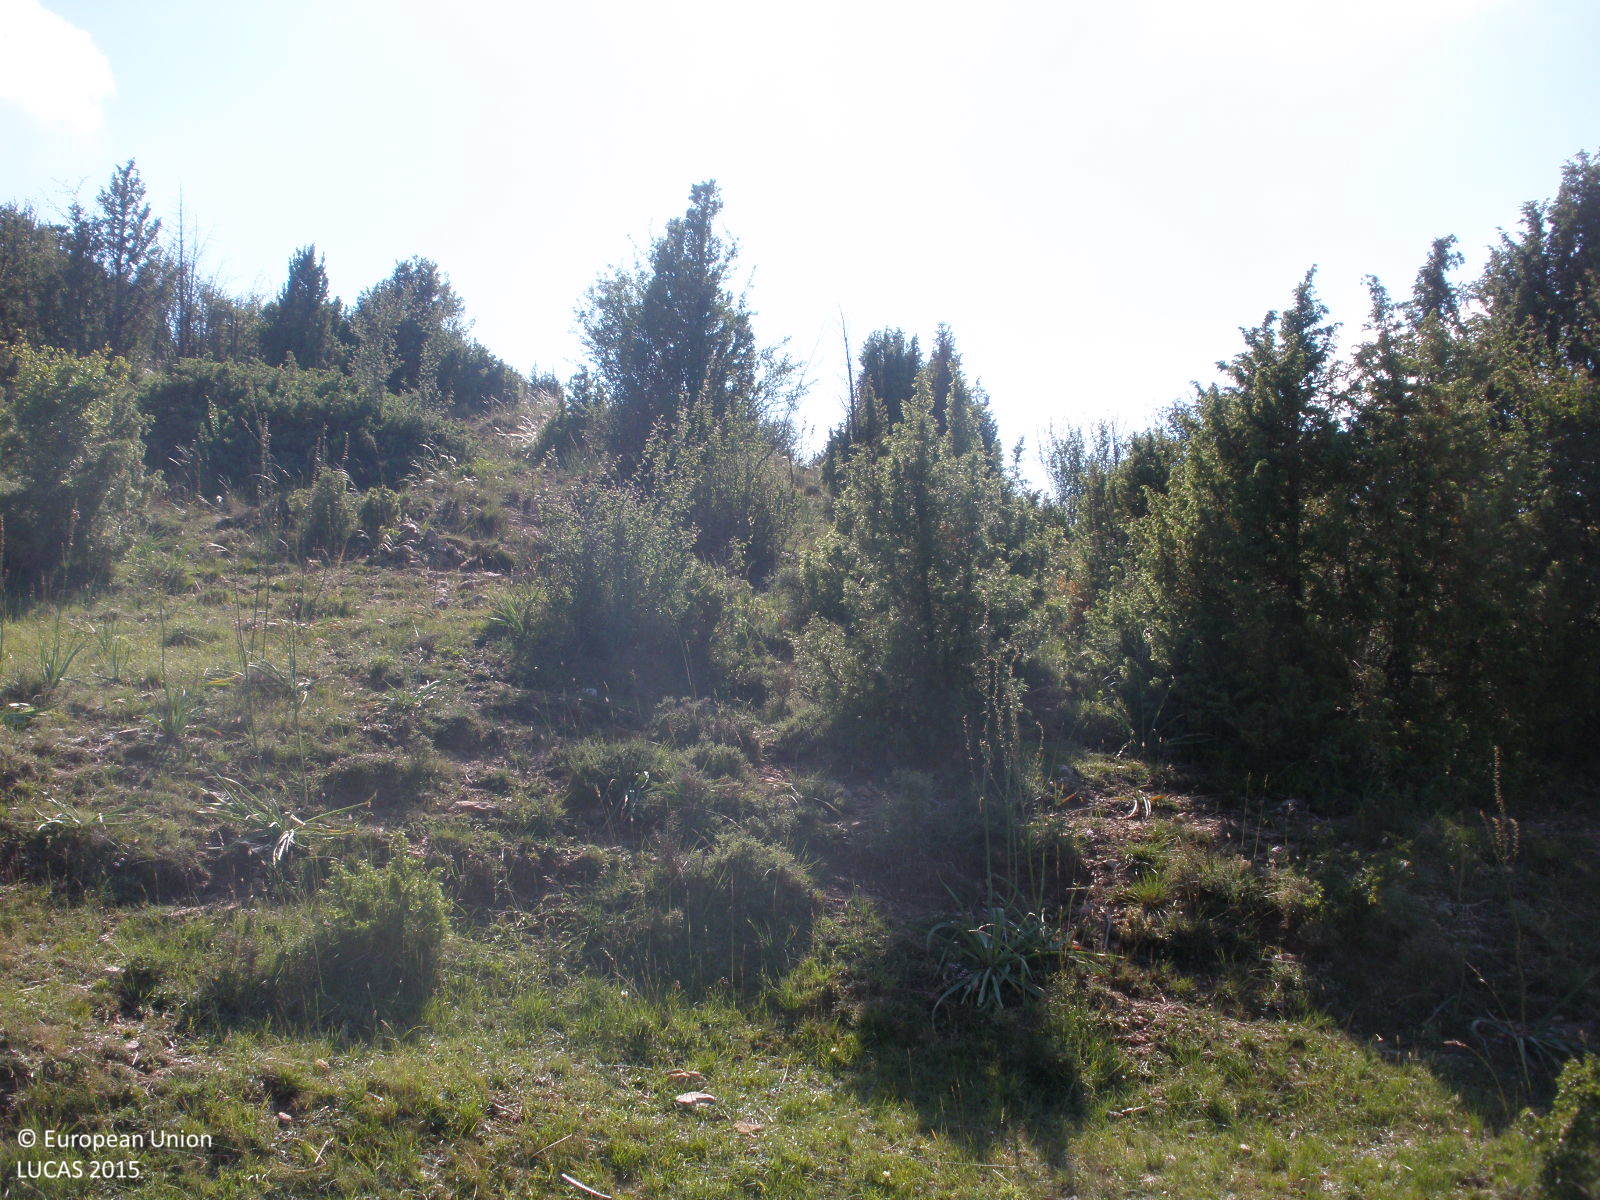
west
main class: Grassland
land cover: Grassland without tree/shrub cover
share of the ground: > 75 %
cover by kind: herbaceous plants 95 %, shrubs 5 %
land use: Agriculture (excluding fallow land and kitchen gardens)
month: June
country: ES
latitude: 40.6120
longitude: -0.8501
